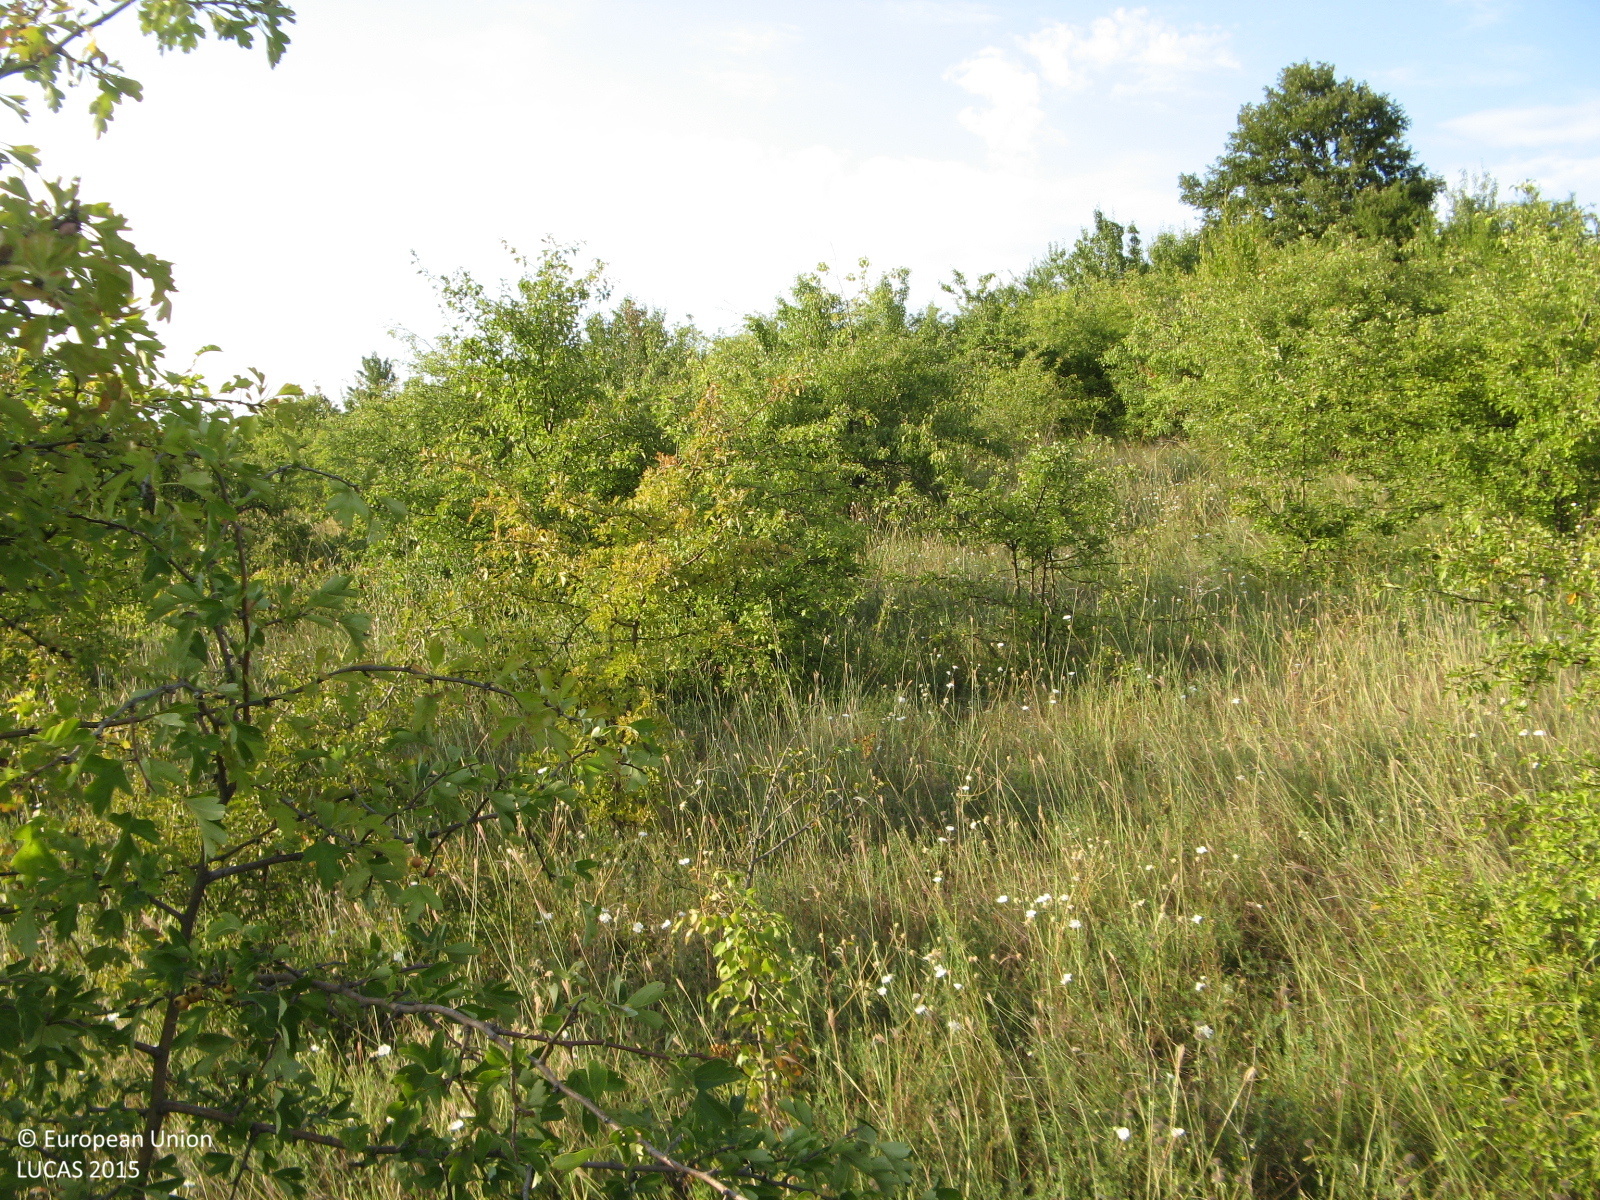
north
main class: Grassland
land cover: Grassland with sparse tree/shrub cover
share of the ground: > 75 %
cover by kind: herbaceous plants 85 %, shrubs 10 %, broadleaved forest trees 5 %
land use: Abandoned areas
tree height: < 5 m
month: August
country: BG
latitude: 43.5321
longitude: 25.8163
